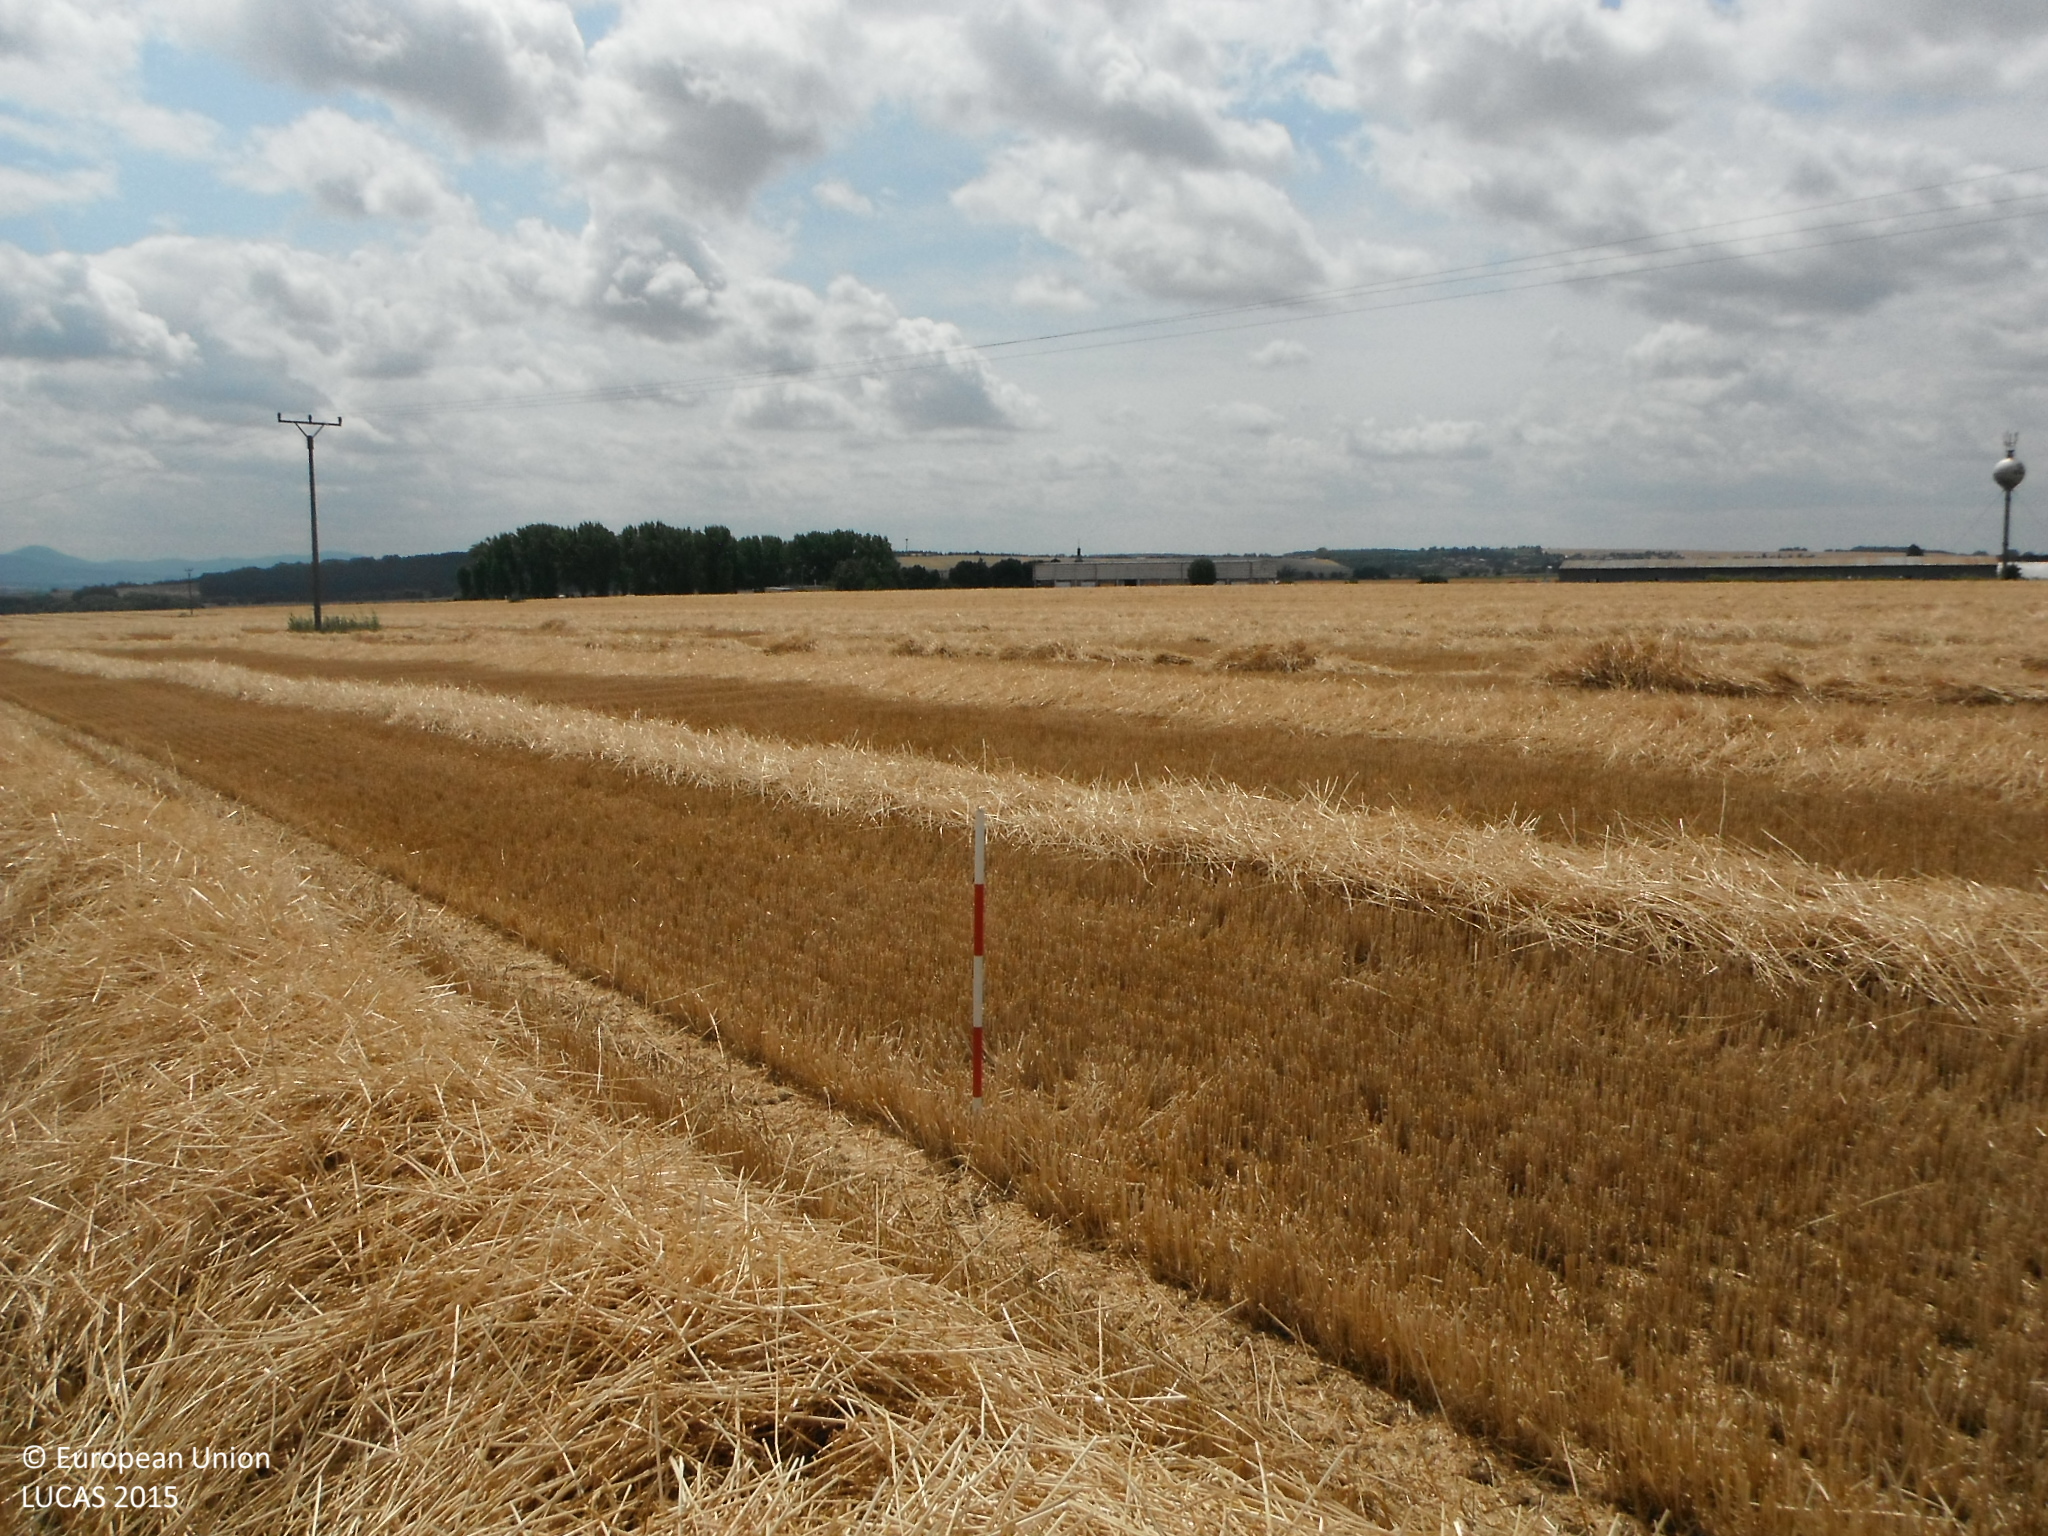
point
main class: Cropland
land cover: Common wheat
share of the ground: > 75 %
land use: Agriculture (excluding fallow land and kitchen gardens)
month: July
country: SK
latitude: 48.5558
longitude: 18.1301
